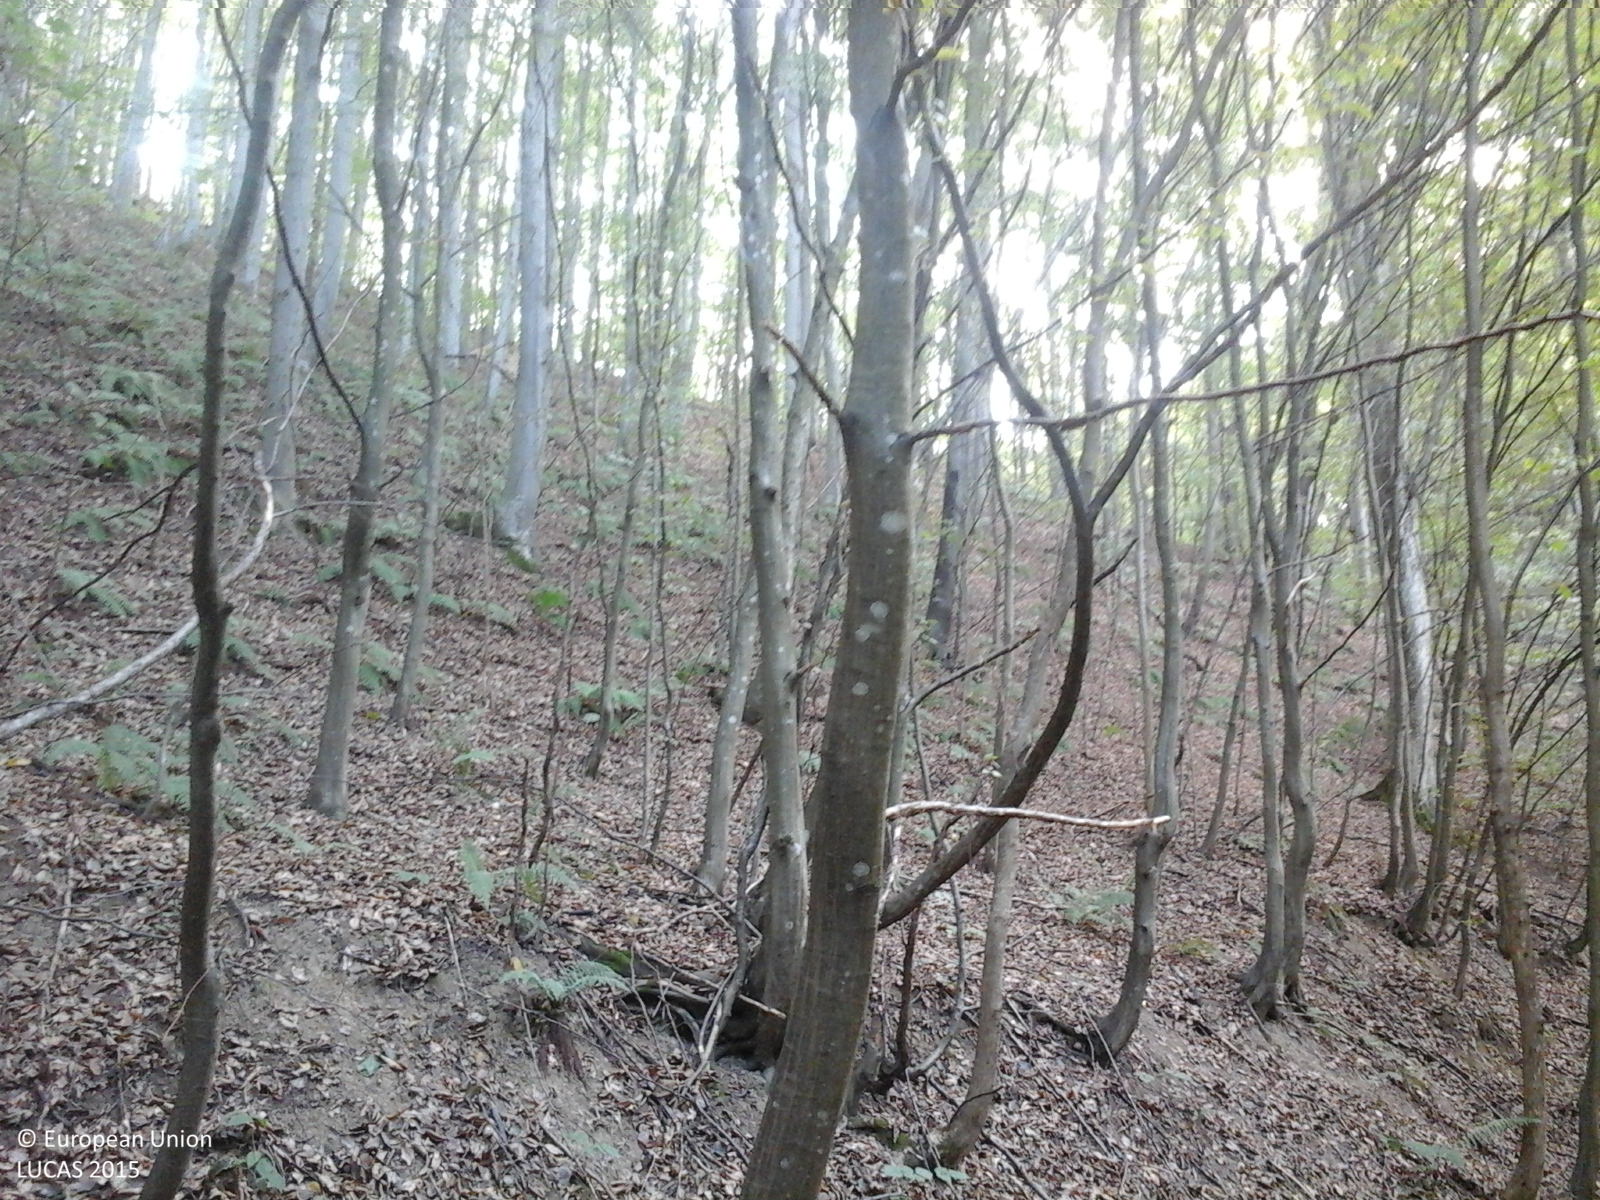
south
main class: Woodland
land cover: Broadleaved woodland
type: beech forest
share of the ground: > 75 %
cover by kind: broadleaved forest trees 100 %
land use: Forestry
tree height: > 5 m
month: September
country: RO
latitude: 45.3812
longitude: 22.0041
